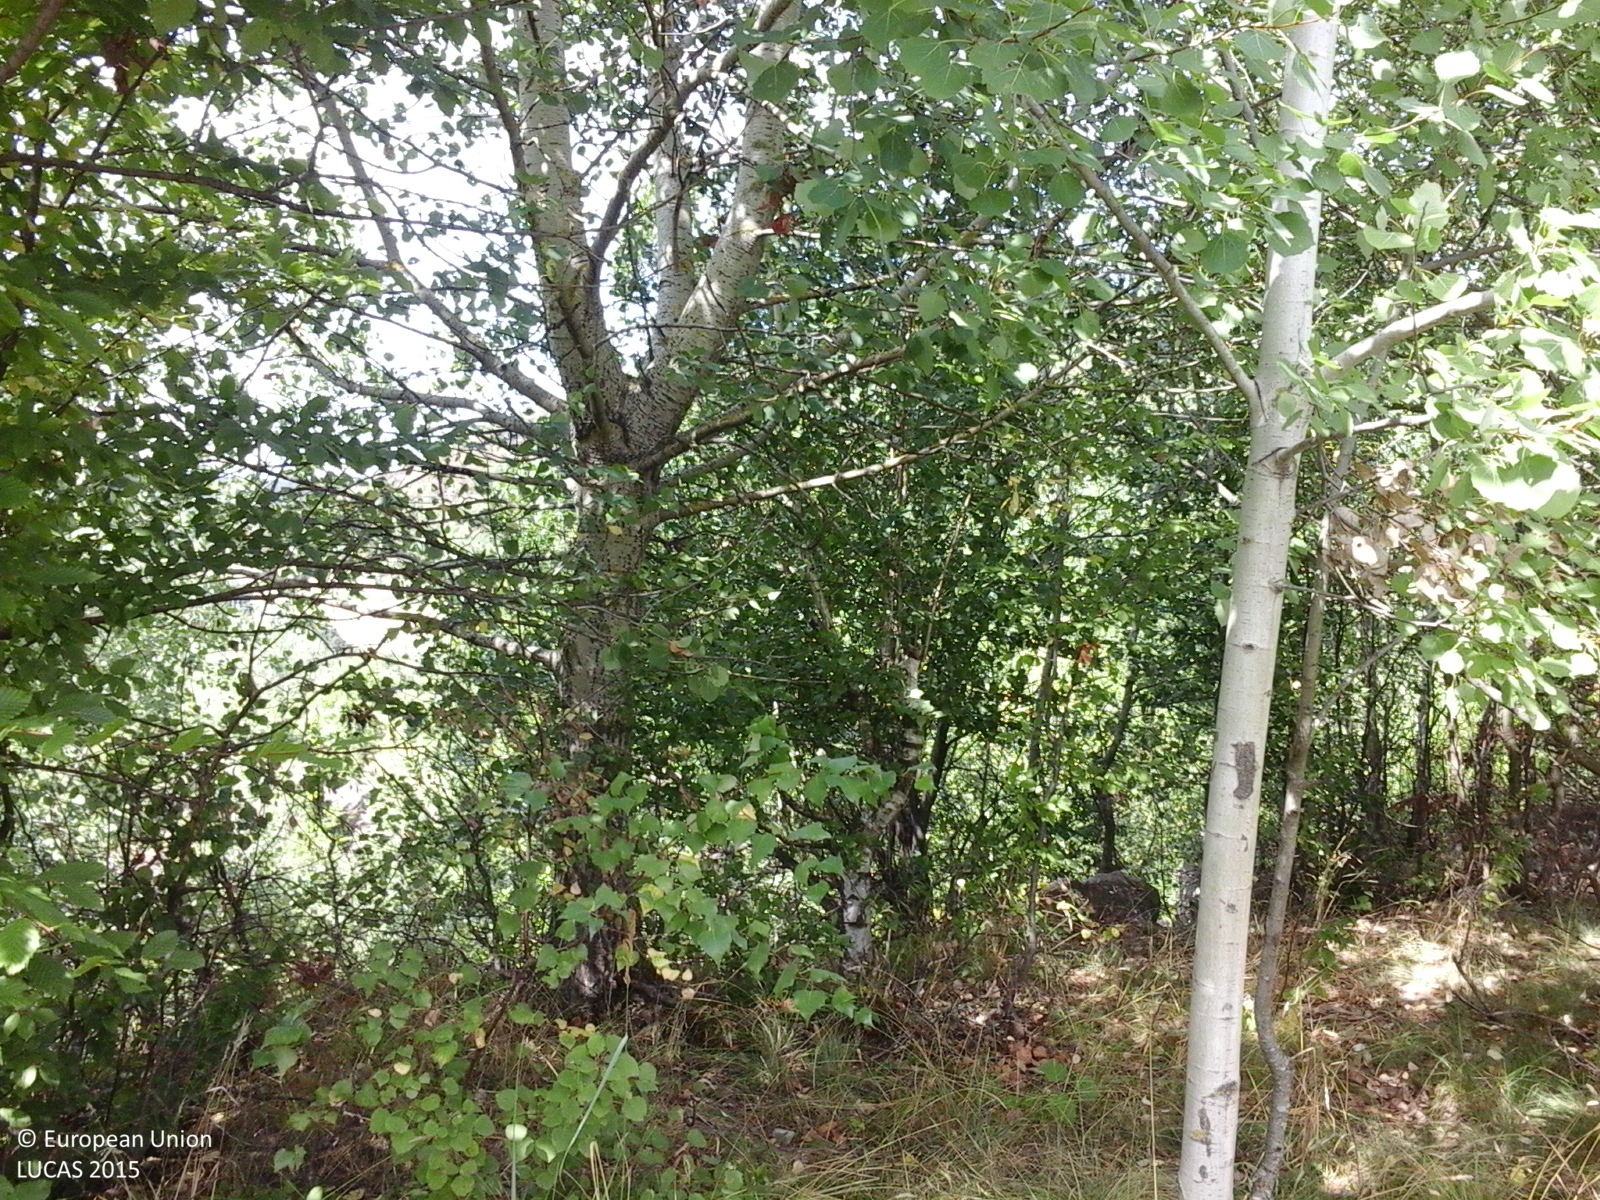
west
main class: Woodland
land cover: Broadleaved woodland
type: beech forest
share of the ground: > 75 %
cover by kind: broadleaved forest trees 100 %
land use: Forestry
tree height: > 5 m
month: August
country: RO
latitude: 45.0552
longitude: 21.8300
